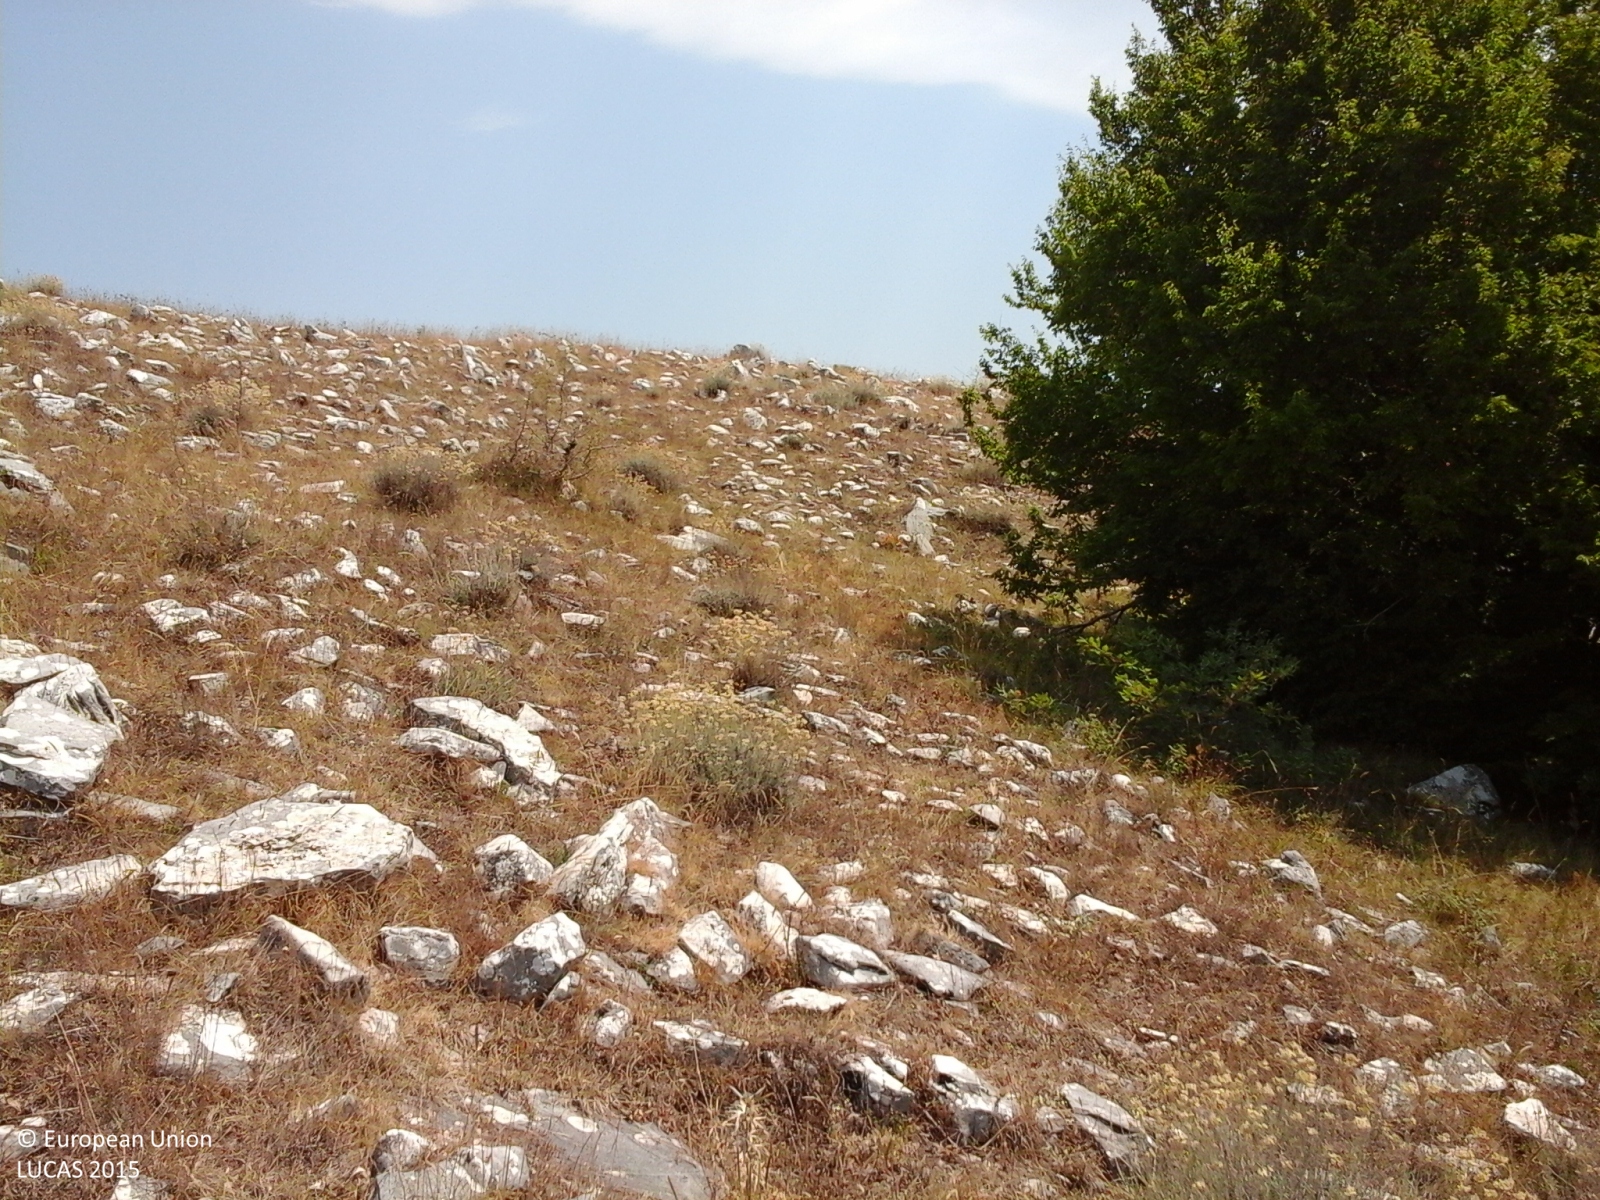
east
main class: Woodland
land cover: Broadleaved woodland
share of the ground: > 75 %
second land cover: Grassland without tree/shrub cover
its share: > 75 %
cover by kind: broadleaved forest trees 85 %, shrubs 10 %, herbaceous plants 5 %
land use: Forestry
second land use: Agriculture (excluding fallow land and kitchen gardens)
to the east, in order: Broadleaved woodland; Grassland without tree/shrub cover; Rocks and stones; Tracks; Rocks and stones; Grassland without tree/shrub cover
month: August
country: IT
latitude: 41.5000
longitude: 14.1894
